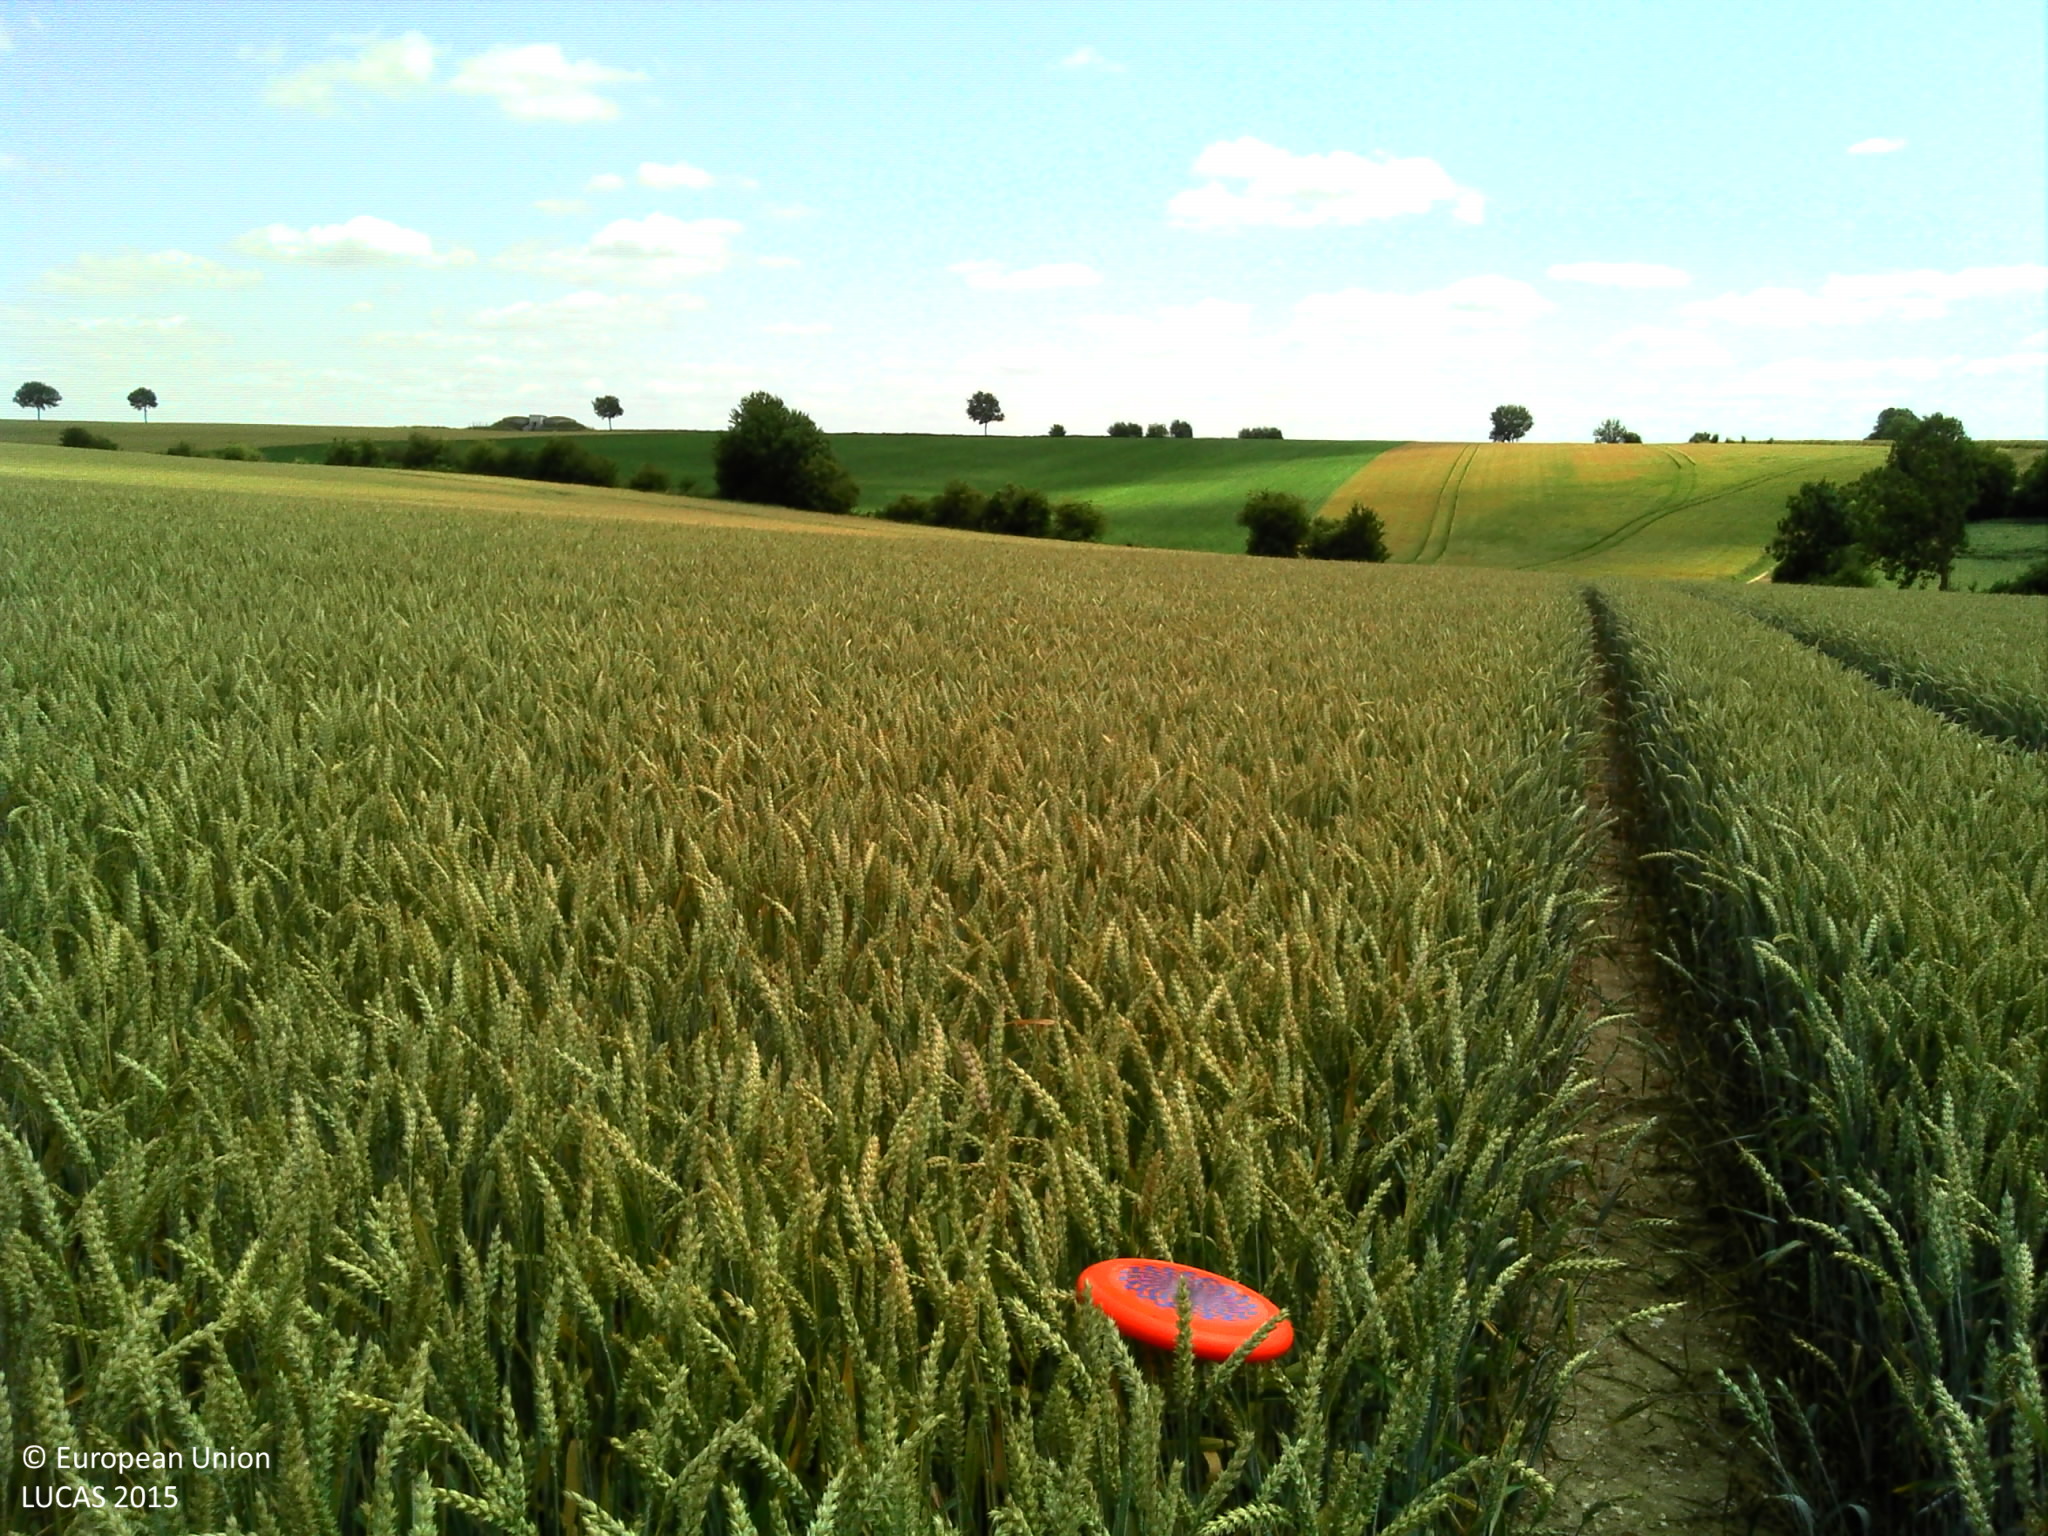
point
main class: Cropland
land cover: Common wheat
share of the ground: > 75 %
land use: Agriculture (excluding fallow land and kitchen gardens)
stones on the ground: 10 - 25 %
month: July
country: FR
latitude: 50.3297
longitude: 2.1608
